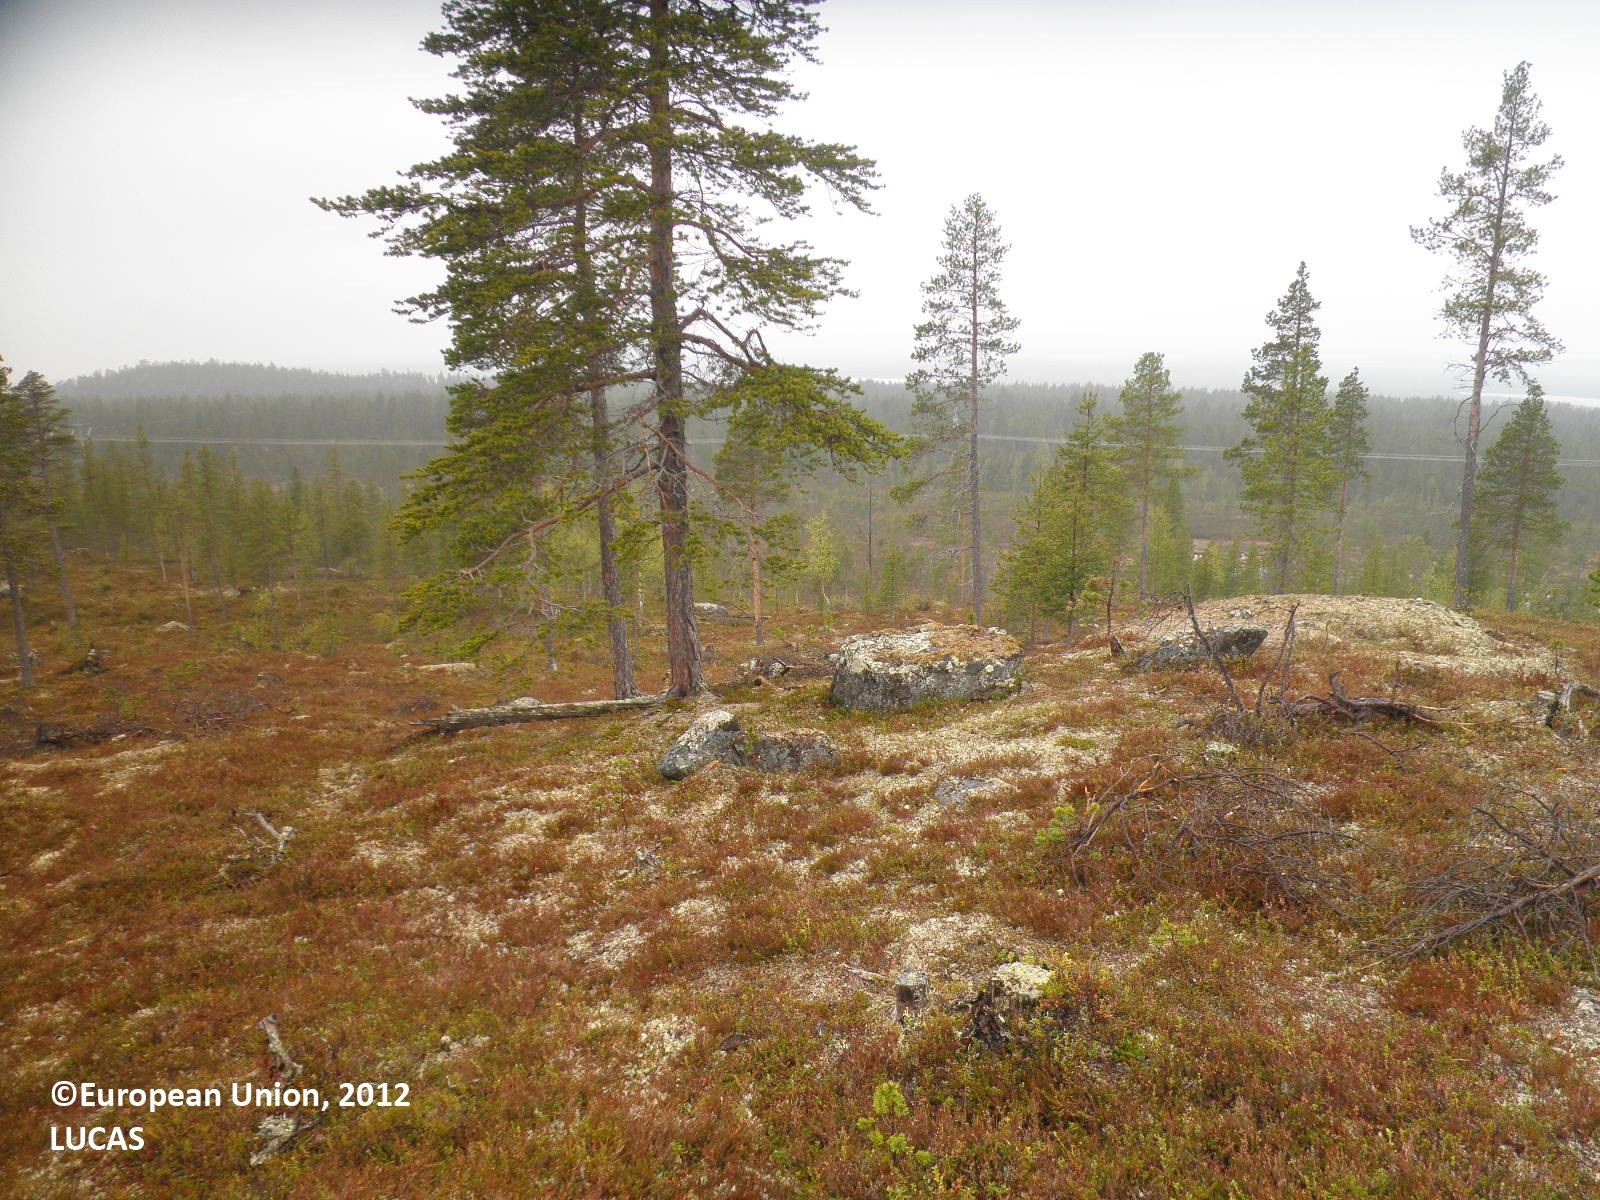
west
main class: Woodland
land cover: Pine dominated coniferous woodland
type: boreal forest
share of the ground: 10 - 25 %
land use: Forestry
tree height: > 5 m
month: June
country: FI
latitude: 69.0809
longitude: 27.2018
